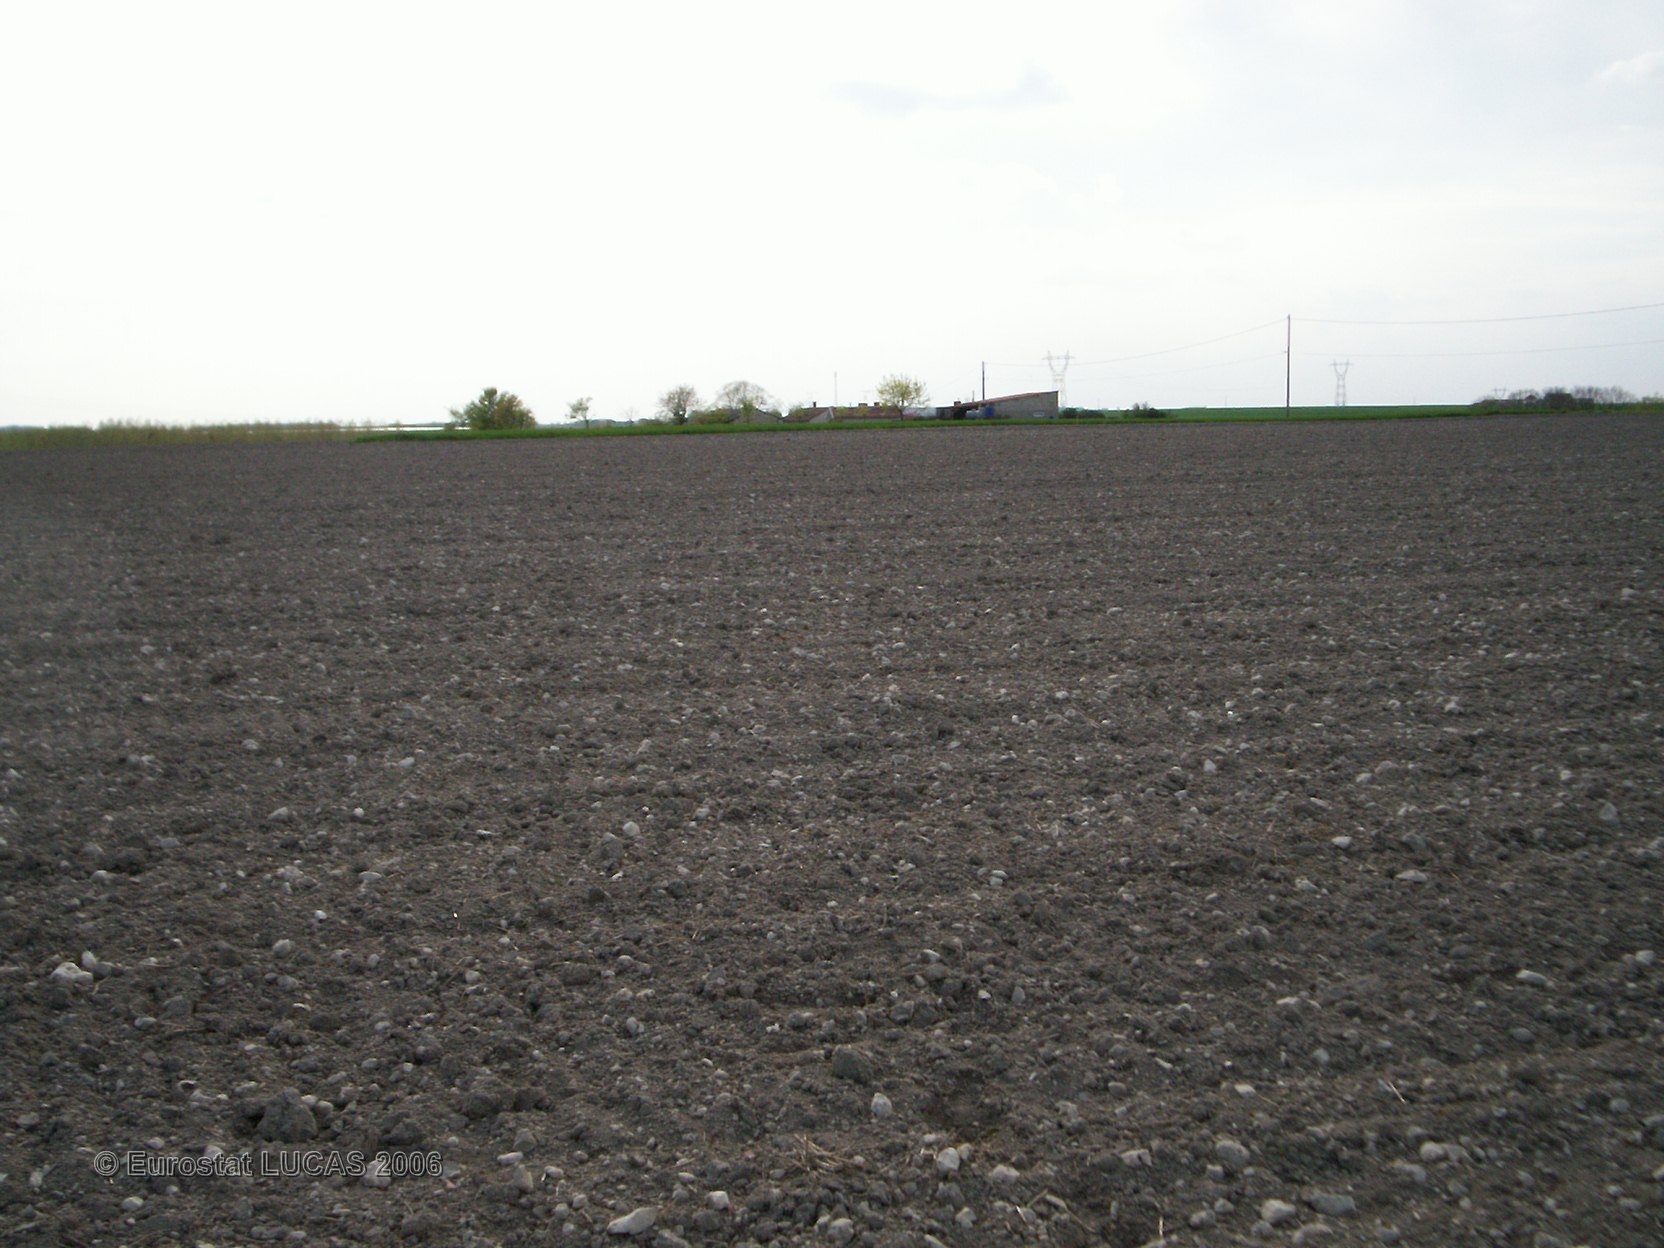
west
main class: Bare land
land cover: Bare land
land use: Agriculture (excluding fallow land and kitchen gardens)
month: April
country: FR
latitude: 46.9520
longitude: 0.4012
